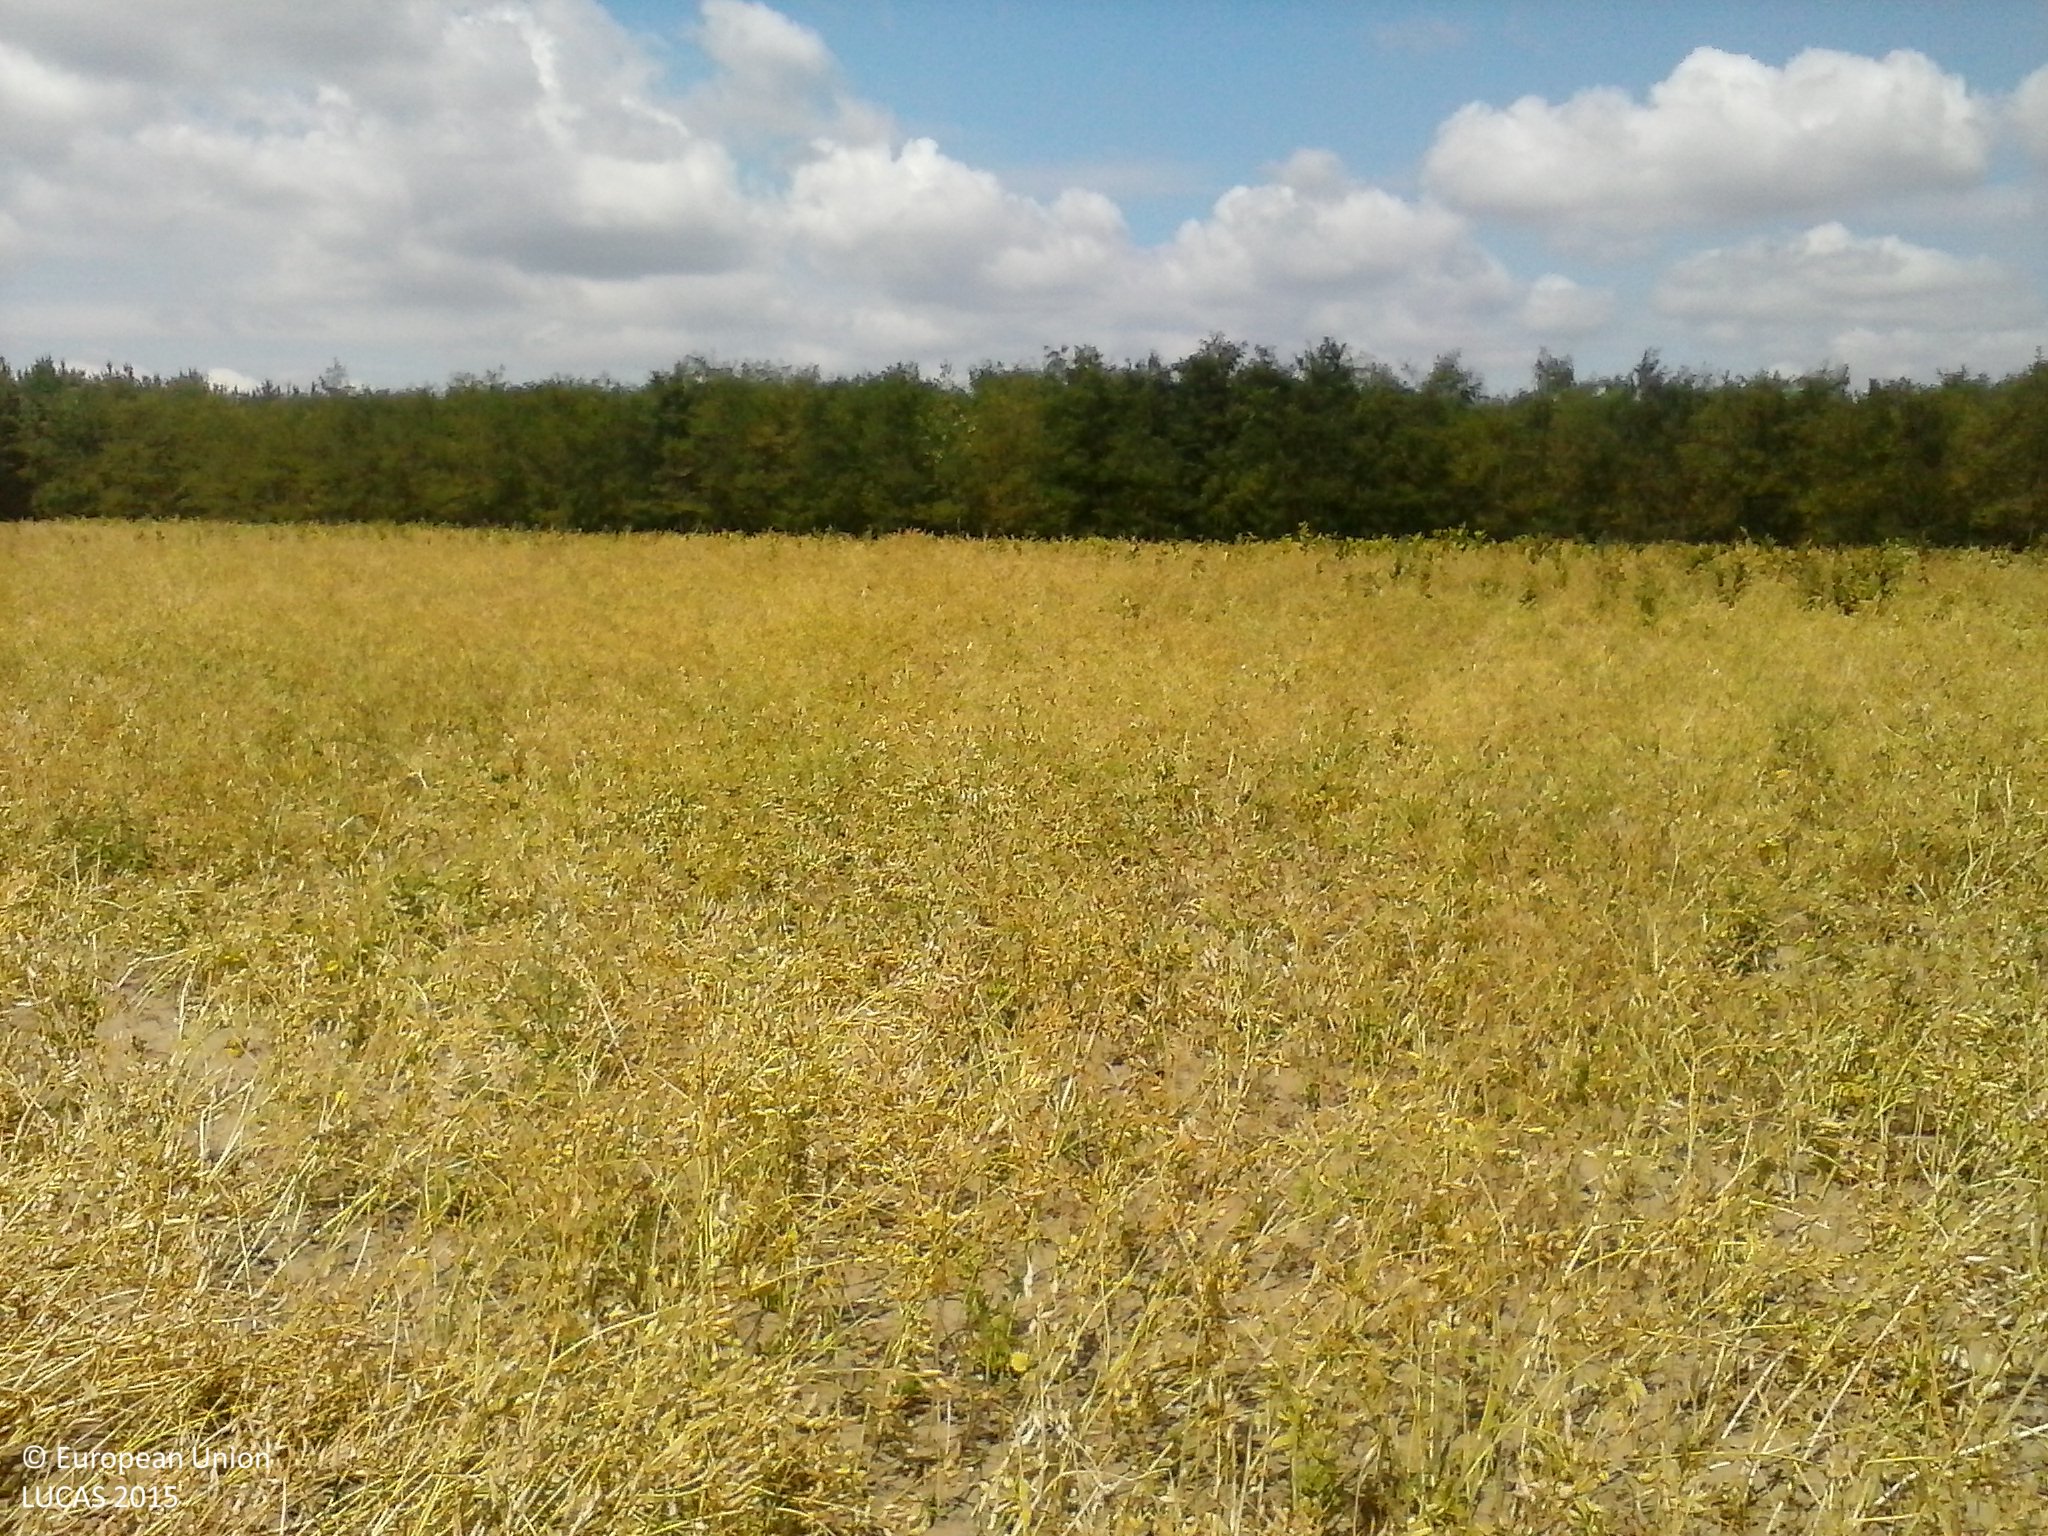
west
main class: Cropland
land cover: Other leguminous and mixtures for fodder
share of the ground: > 75 %
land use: Agriculture (excluding fallow land and kitchen gardens)
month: July
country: HU
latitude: 46.6062
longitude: 19.6147
